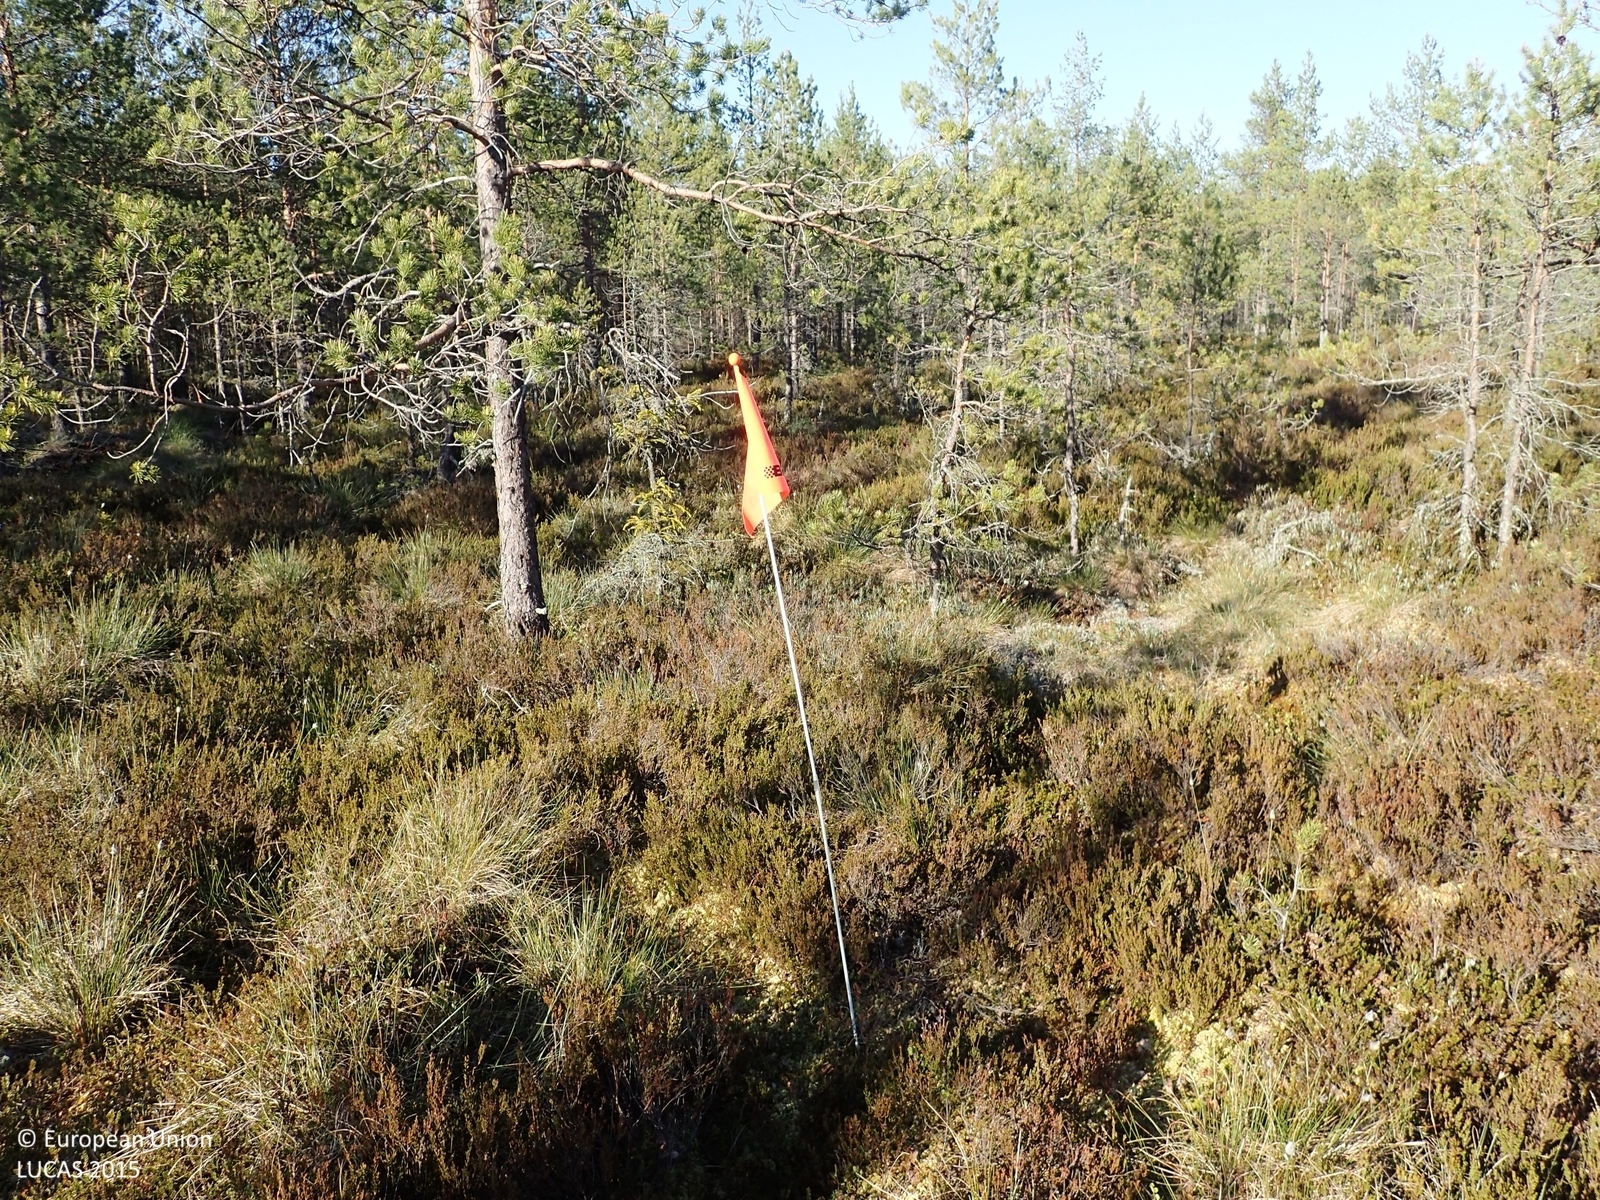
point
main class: Woodland
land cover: Pine dominated coniferous woodland
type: boreal forest
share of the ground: 50 - 75 %
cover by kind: coniferous forest trees 50 %, shrubs 50 %
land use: Forestry
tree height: > 5 m
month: June
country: FI
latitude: 62.2050
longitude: 21.7553
